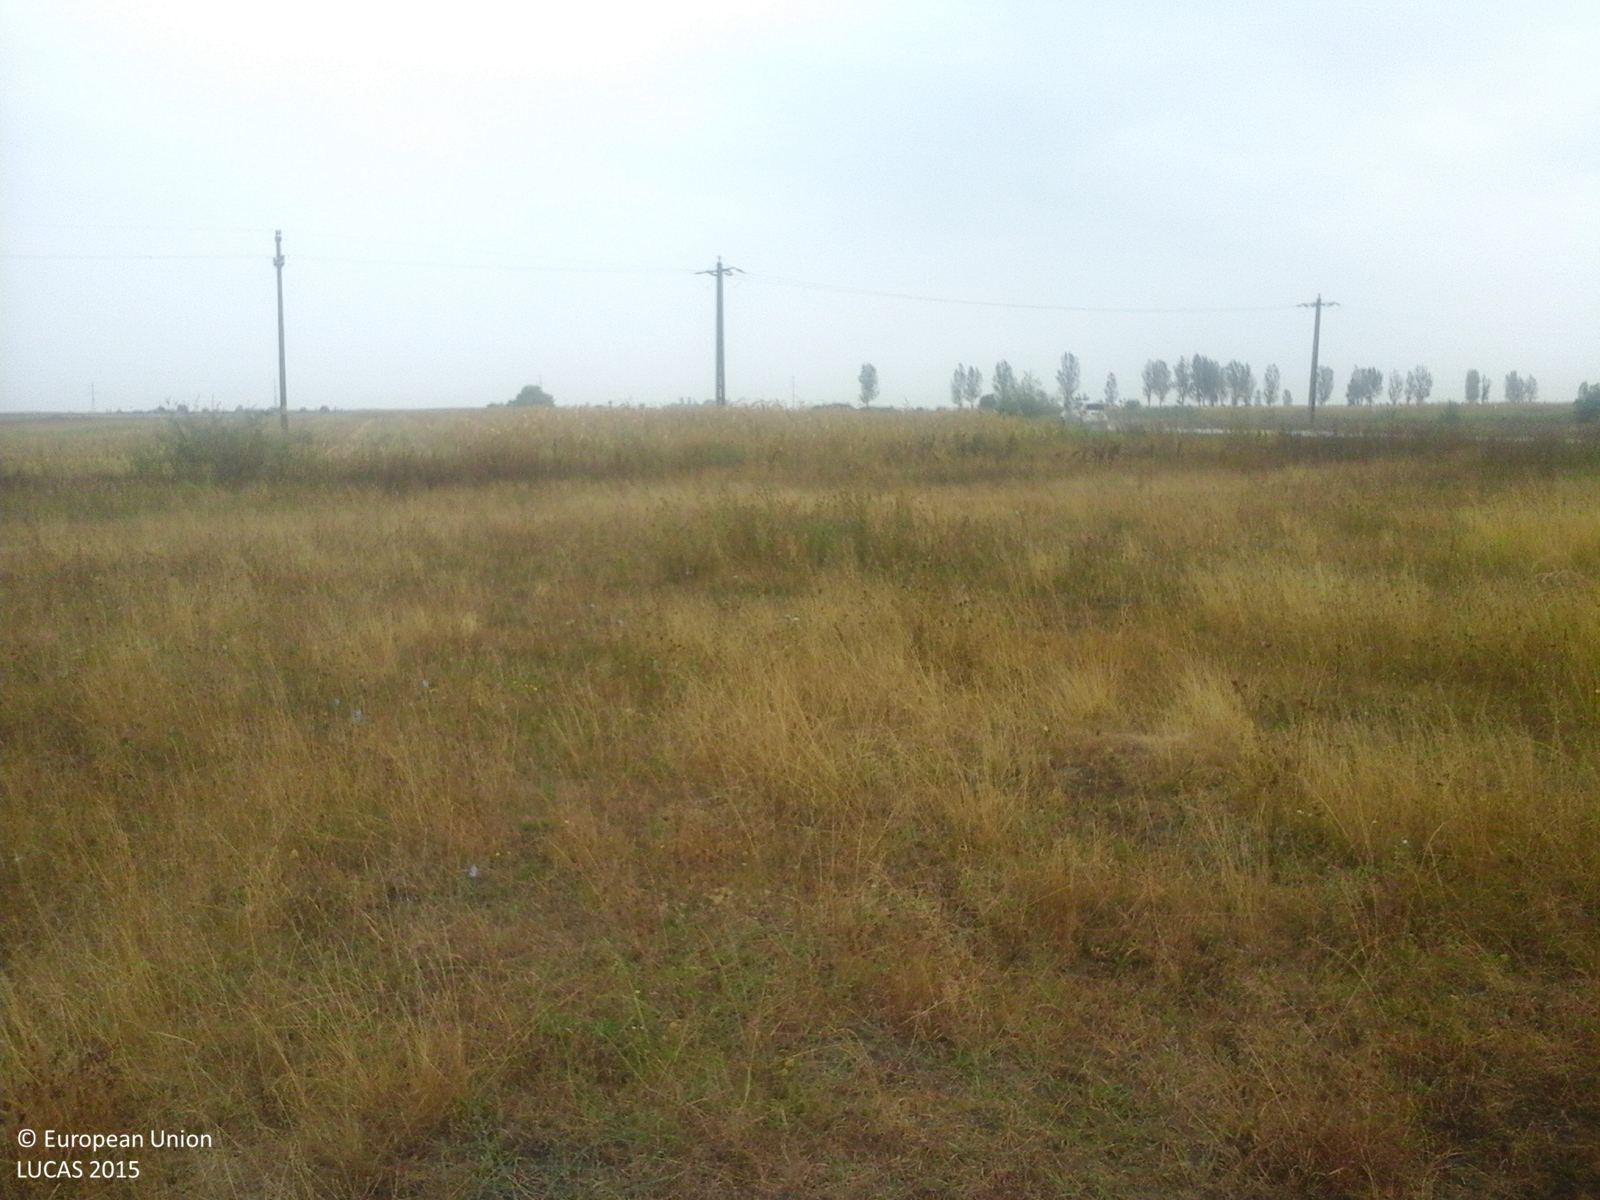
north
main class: Grassland
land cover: Grassland without tree/shrub cover
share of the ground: > 75 %
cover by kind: herbaceous plants 100 %
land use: Agriculture (excluding fallow land and kitchen gardens)
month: September
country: RO
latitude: 47.5945
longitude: 22.5460
